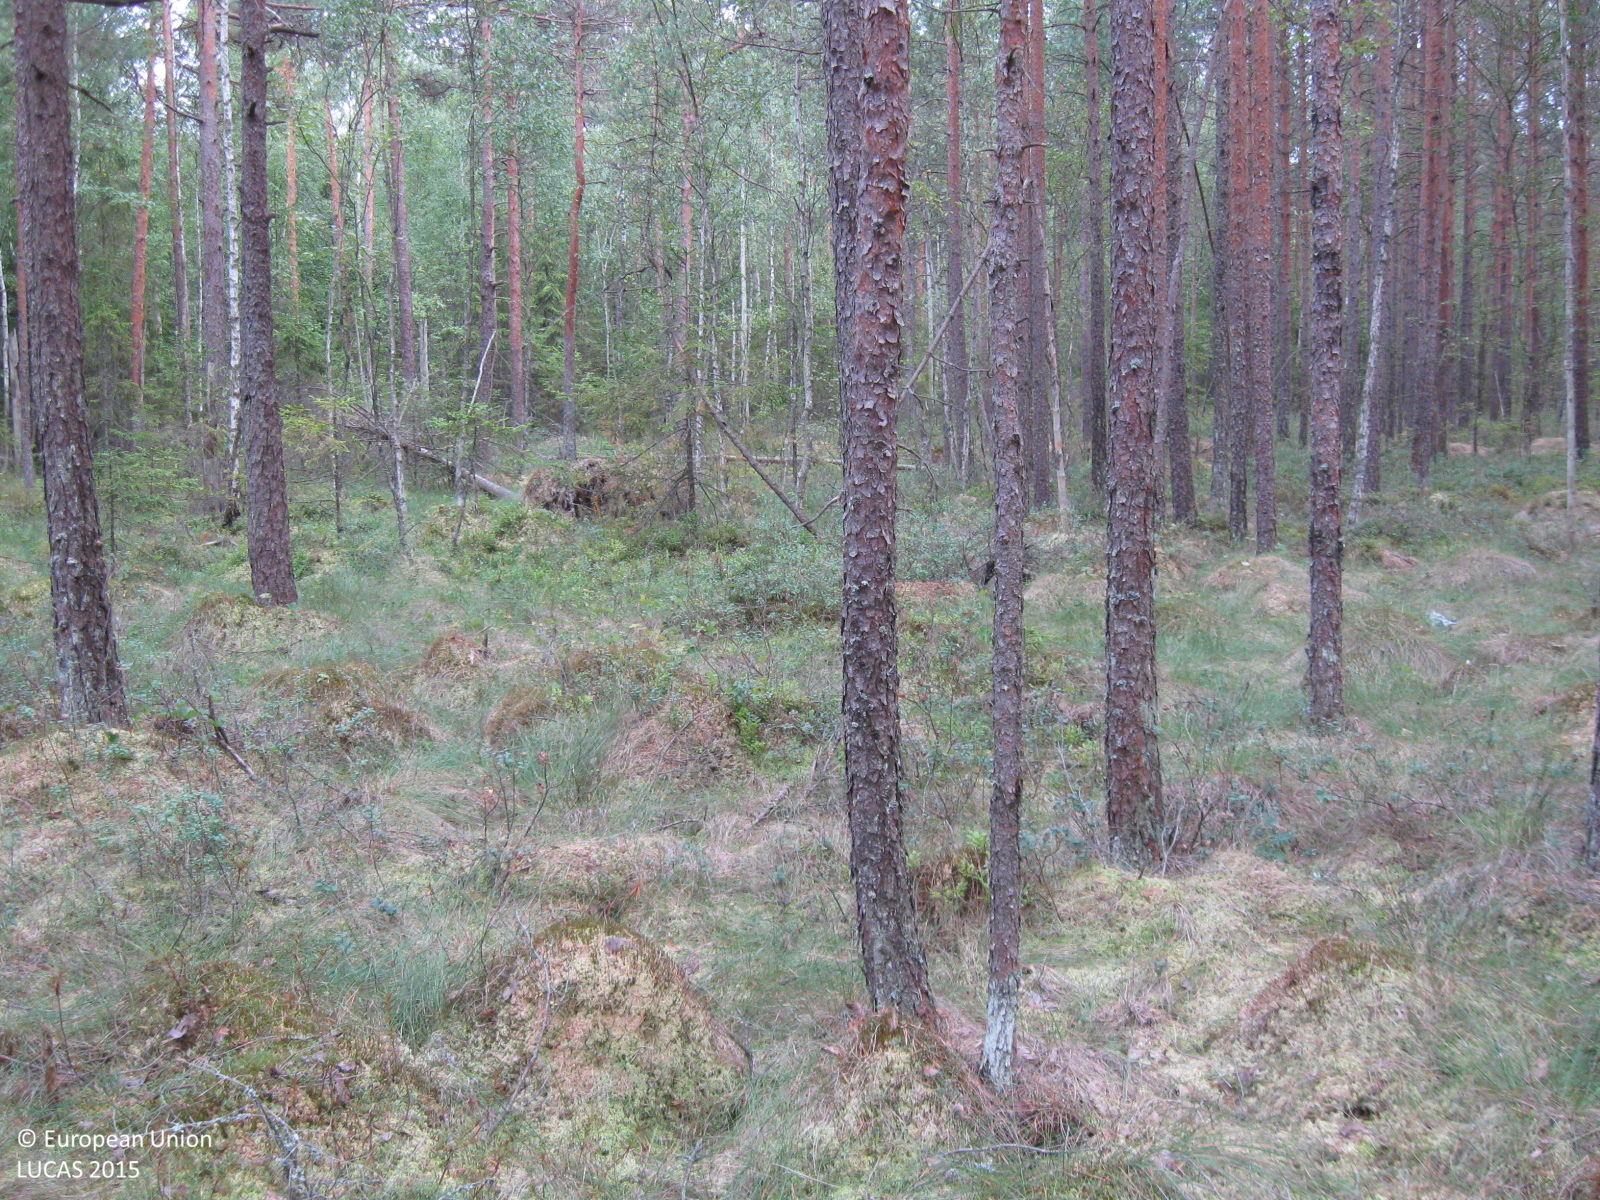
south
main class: Woodland
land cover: Pine dominated coniferous woodland
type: mire and swamp forests
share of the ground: > 75 %
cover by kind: coniferous forest trees 75 %, herbaceous plants 10 %, lichens and mosses 10 %, broadleaved forest trees 5 %
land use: Forestry
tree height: > 5 m
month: August
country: LT
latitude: 55.5594
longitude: 23.3462
